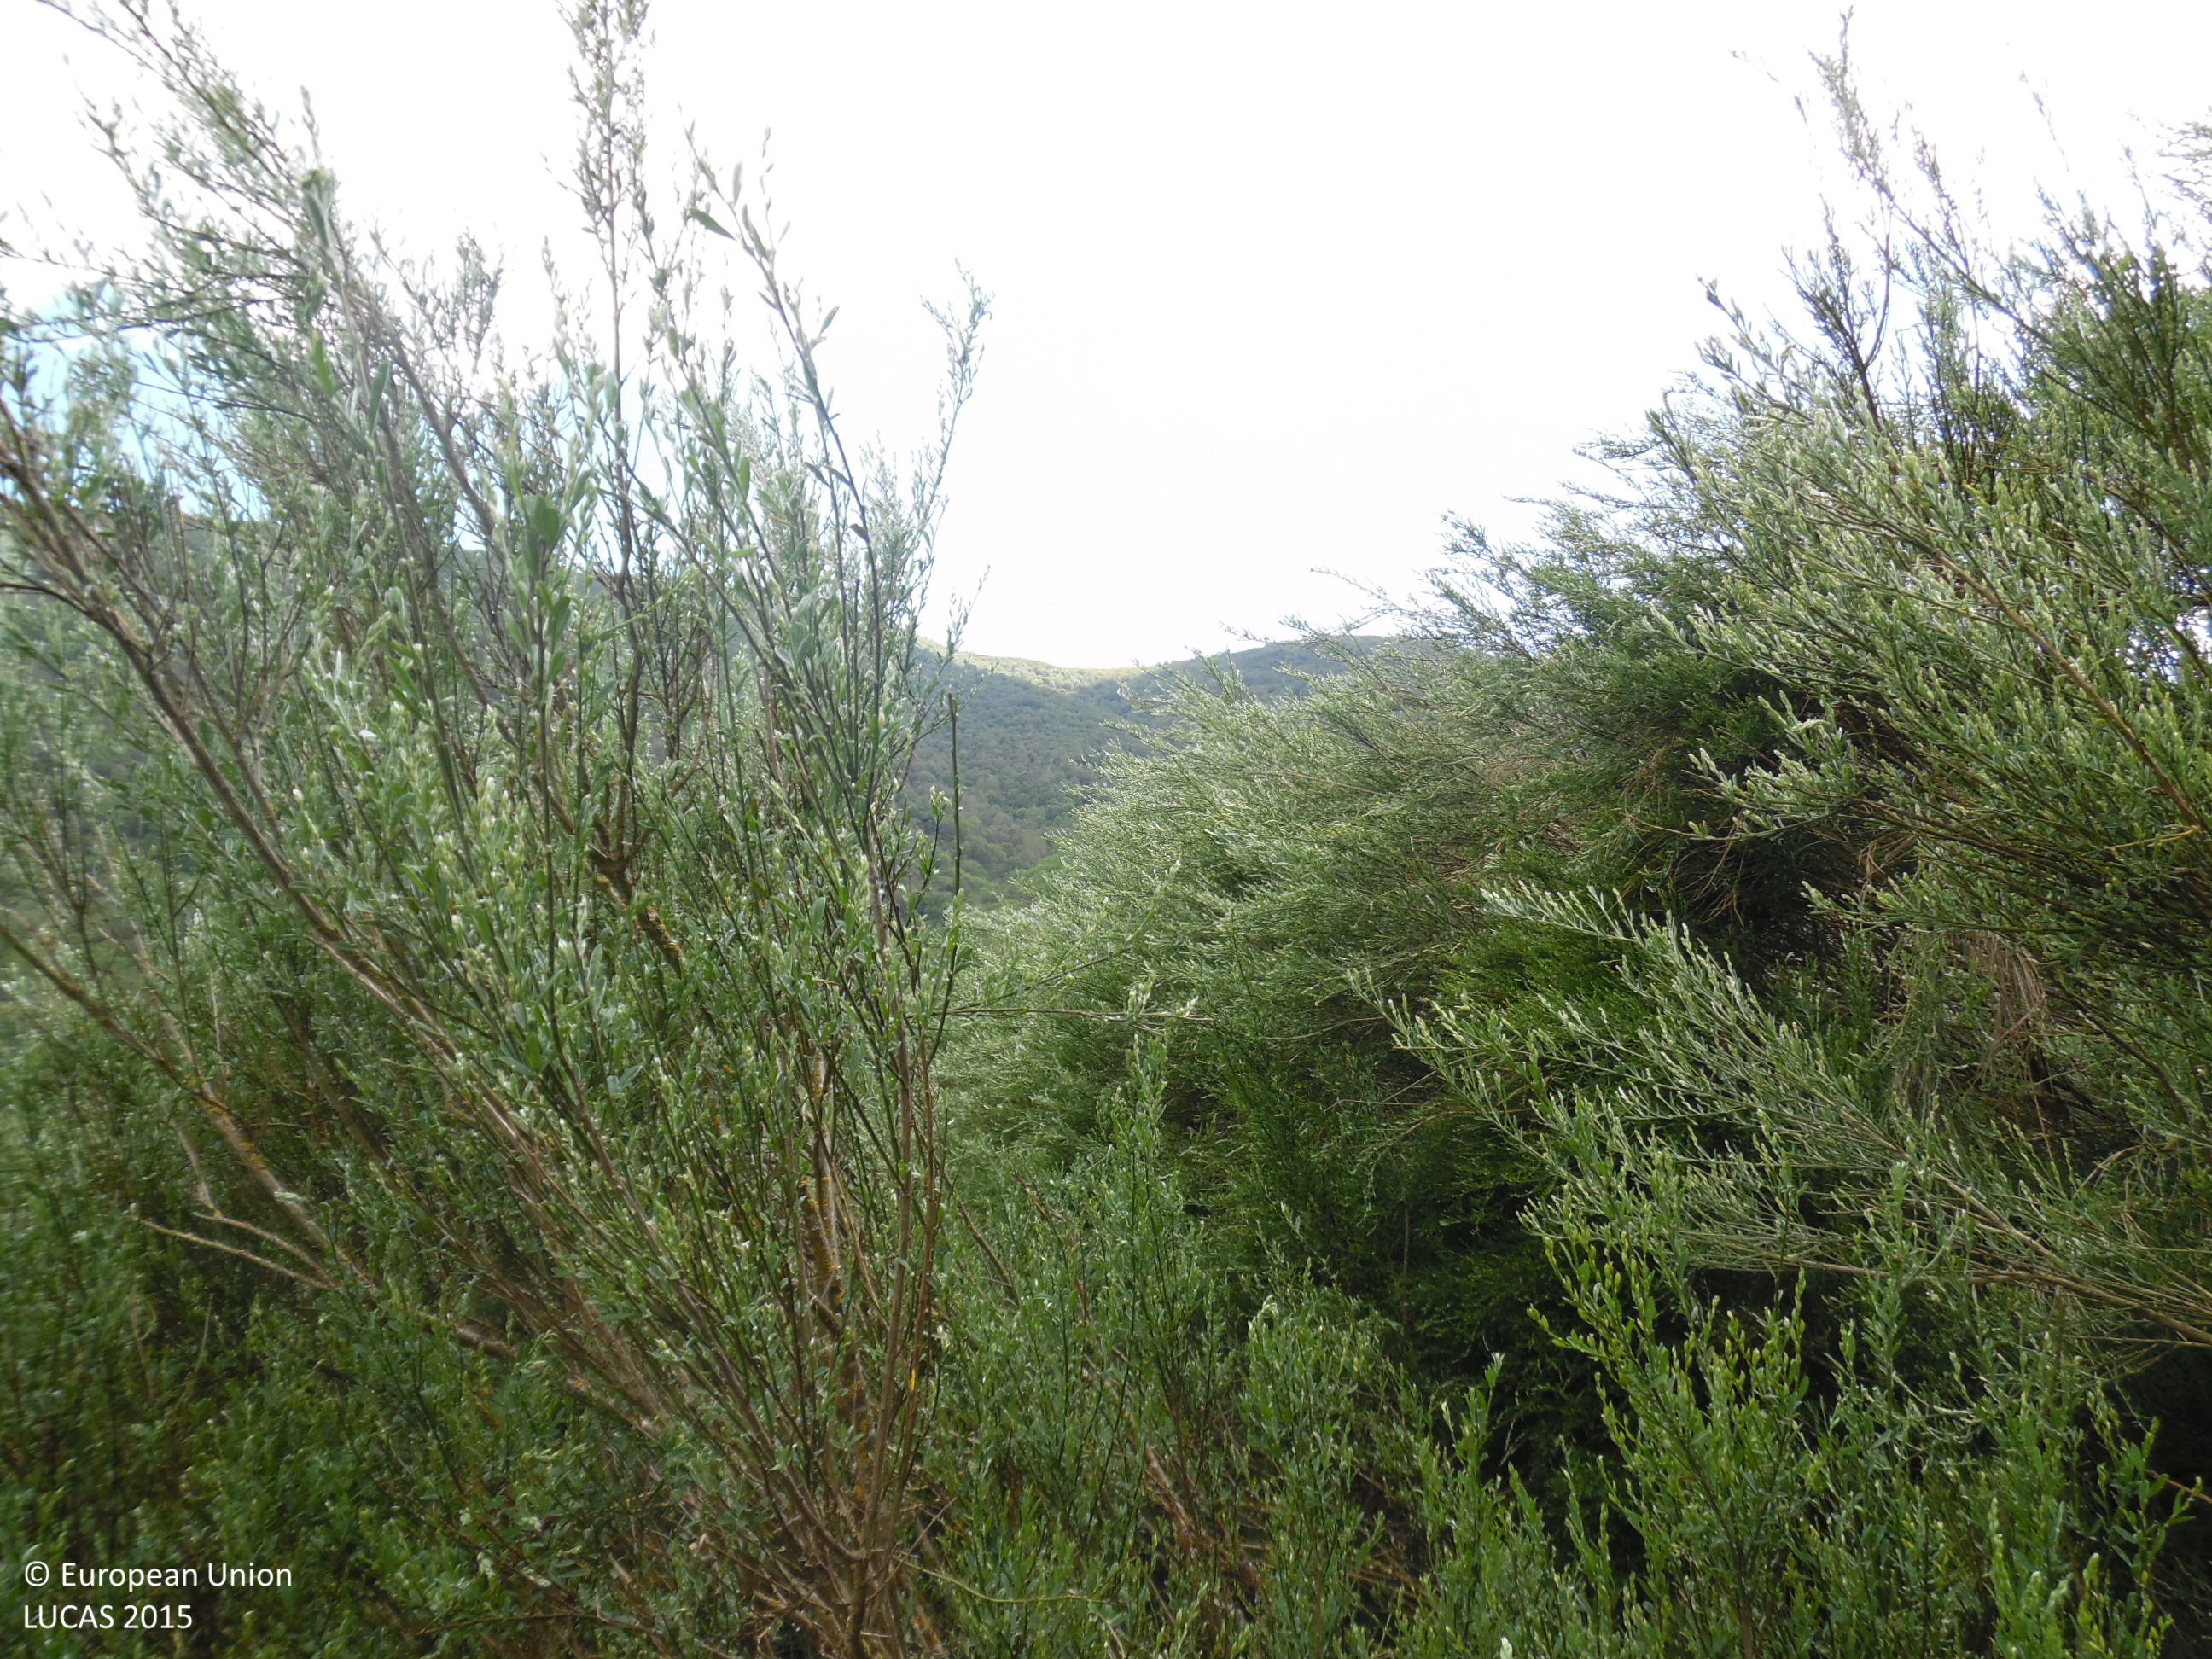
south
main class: Shrubland
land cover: Shrubland with sparse tree cover
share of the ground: 50 - 75 %
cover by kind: shrubs 85 %, herbaceous plants 10 %, coniferous forest trees 5 %
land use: Abandoned areas
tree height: < 5 m
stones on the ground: 10 - 25 %
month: May
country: ES
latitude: 42.8500
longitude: -6.1809
